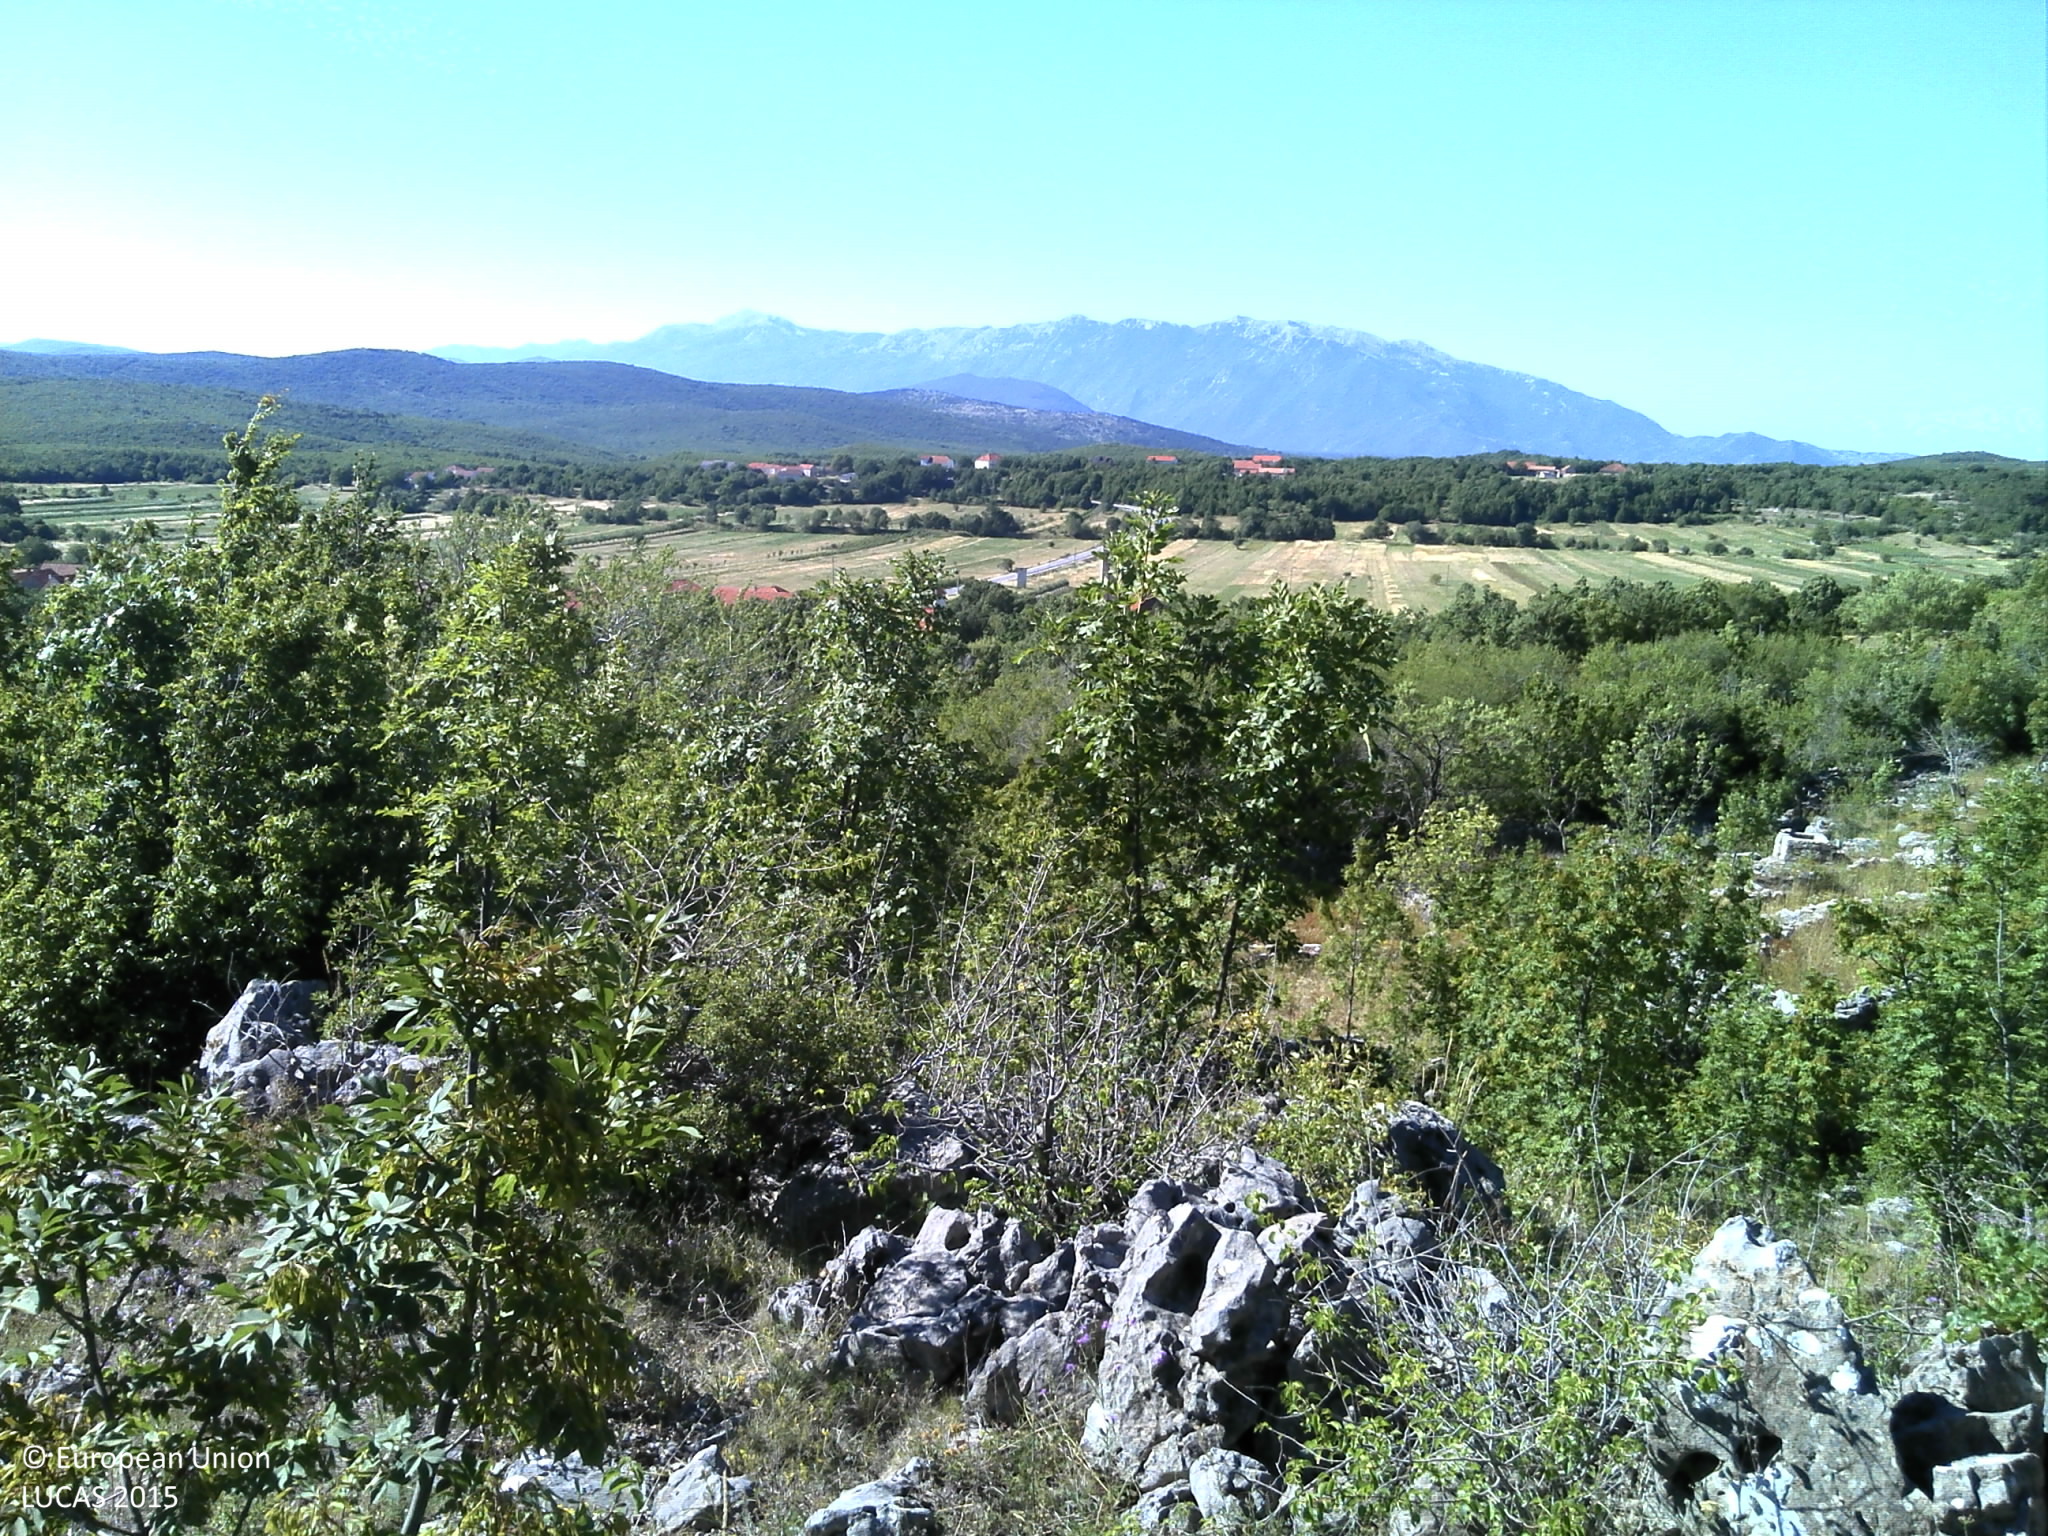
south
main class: Shrubland
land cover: Shrubland with sparse tree cover
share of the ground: 50 - 75 %
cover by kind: shrubs 60 %, herbaceous plants 25 %, consolidated bare surface 10 %, broadleaved forest trees 5 %
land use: Semi-natural and natural areas not in use
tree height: < 5 m
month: July
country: HR
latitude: 43.5555
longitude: 16.9611
